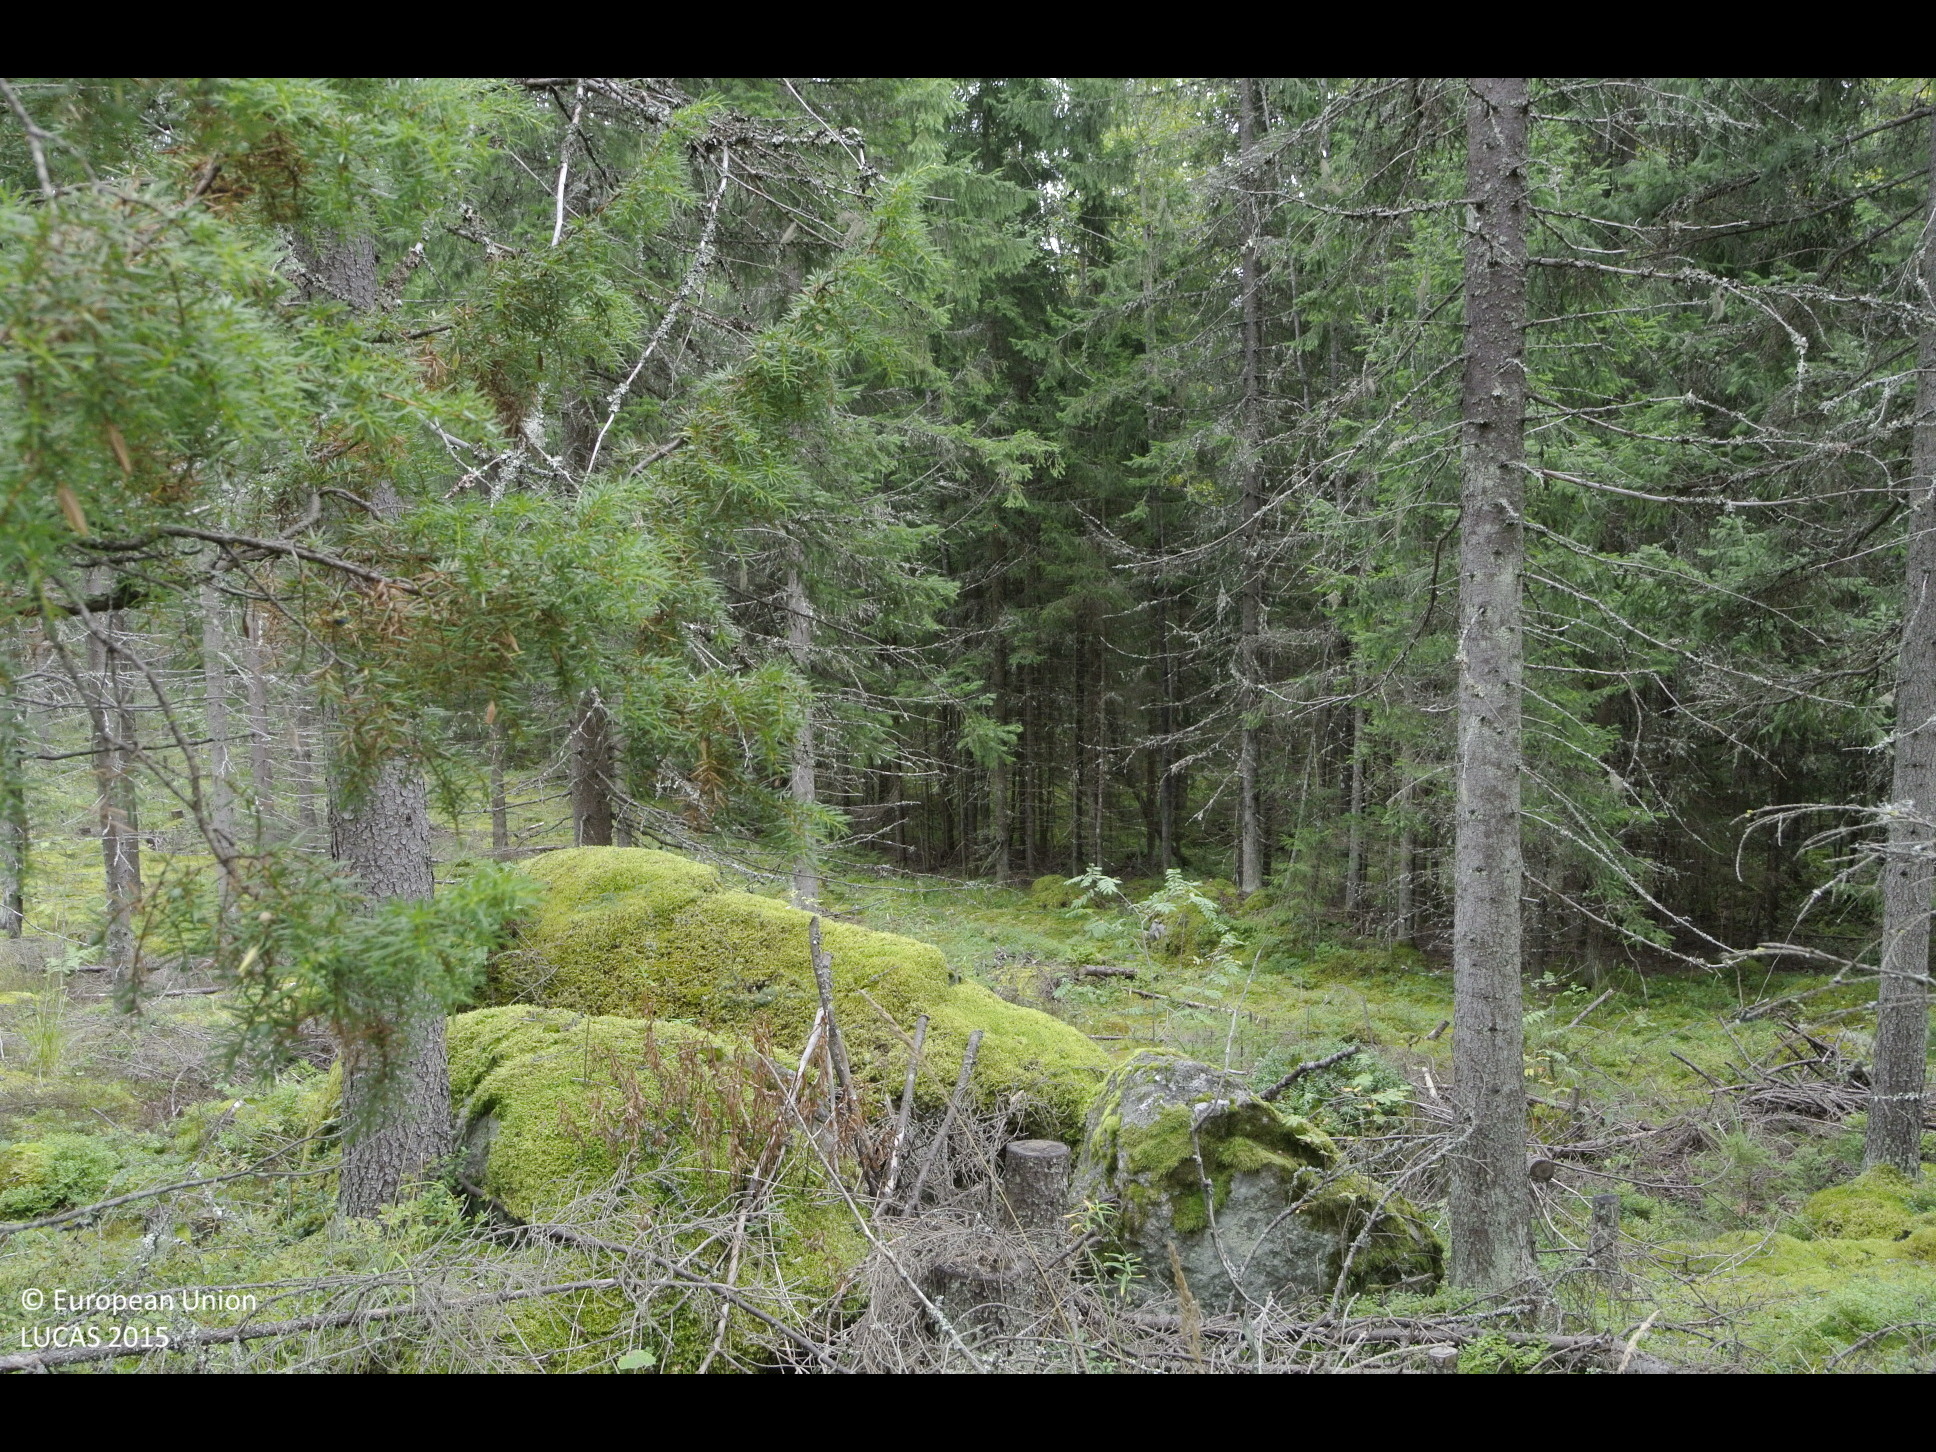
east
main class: Woodland
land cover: Spruce dominated coniferous woodland
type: boreal forest
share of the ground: > 75 %
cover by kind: coniferous forest trees 80 %, broadleaved forest trees 5 %, shrubs 5 %, lichens and mosses 5 %
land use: Forestry
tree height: > 5 m
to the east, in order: Spruce dominated coniferous woodland; Tracks; Spruce dominated coniferous woodland; Spruce dominated mixed woodland; Ditches and canals; Grass margins; Tracks; Grass margins; Abandoned hedges; Ditches and canals; Grass margins; Other leguminous and mixtures for fodder
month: September
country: FI
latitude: 60.4772
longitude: 25.3160
